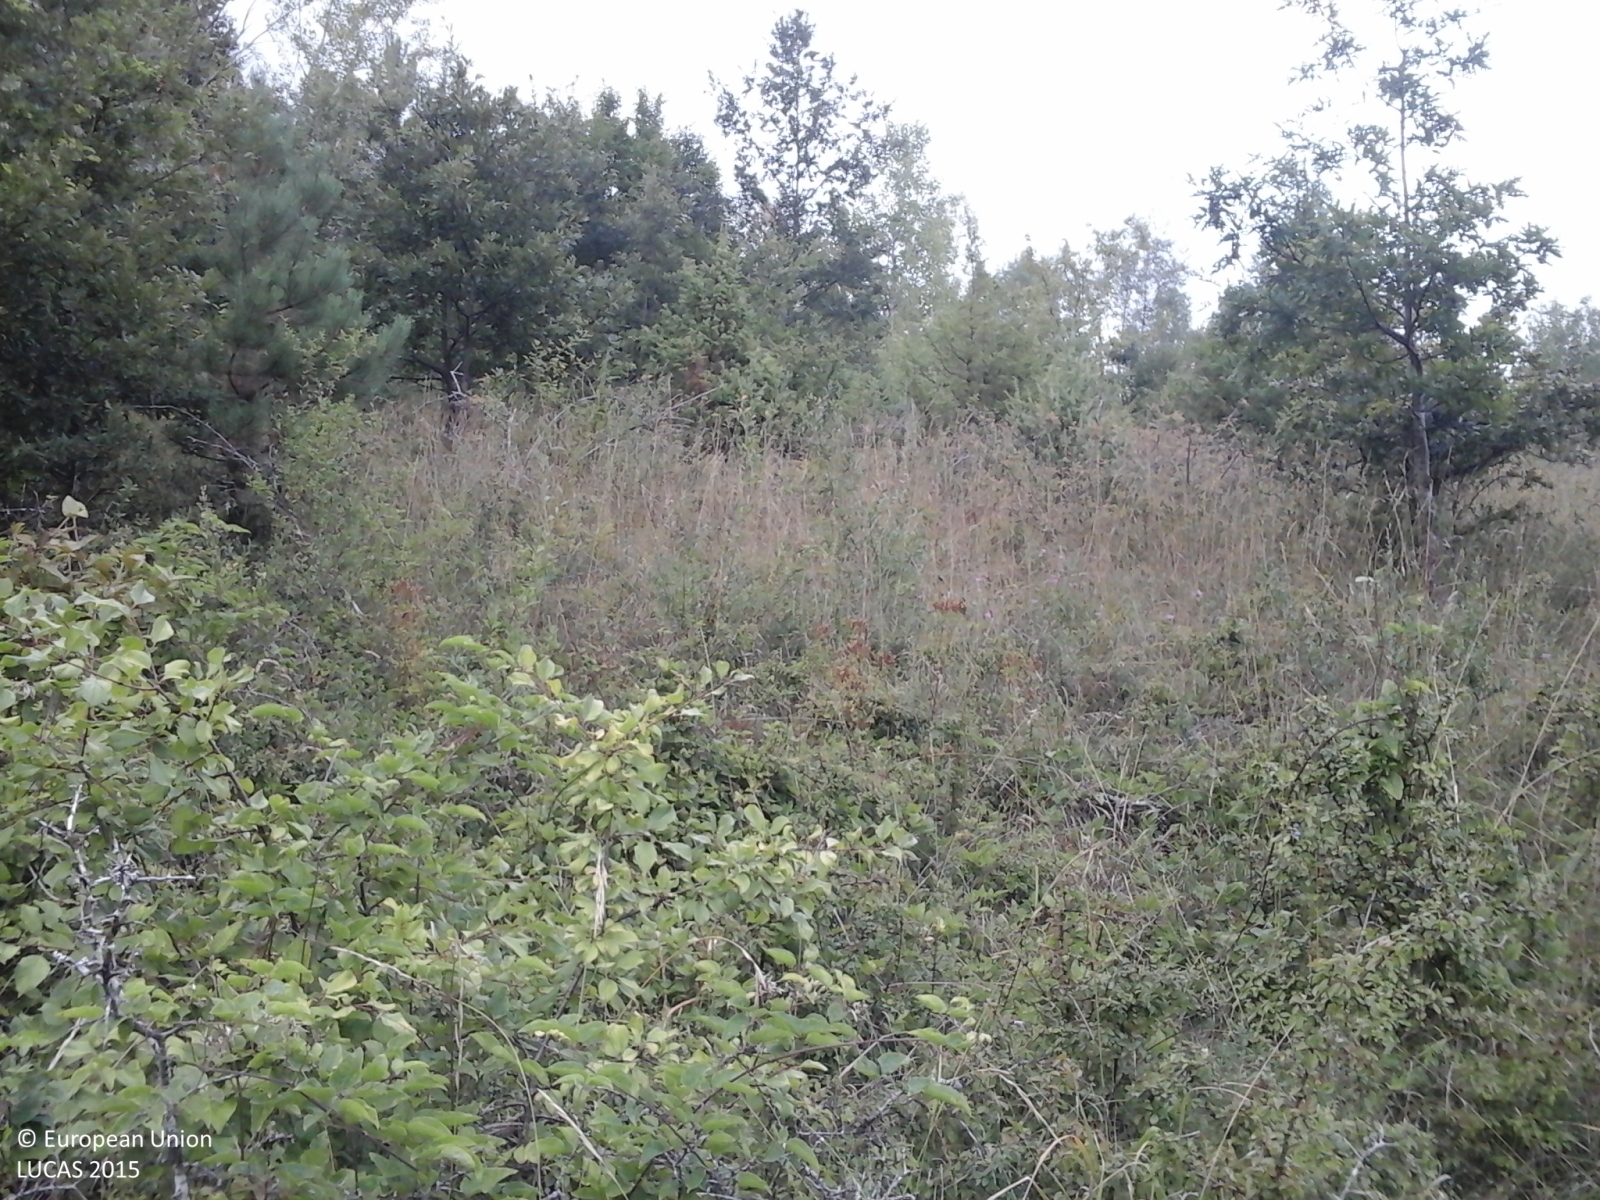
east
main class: Woodland
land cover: Broadleaved woodland
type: thermophilous deciduous forest
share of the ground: > 75 %
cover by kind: broadleaved forest trees 40 %, shrubs 40 %, herbaceous plants 15 %, coniferous forest trees 5 %
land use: Semi-natural and natural areas not in use
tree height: > 5 m
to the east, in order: Broadleaved woodland; Grassland with sparse tree/shrub cover; Other mixed woodland; Shrubland without tree cover; Other mixed woodland
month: August
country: IT
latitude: 44.7450
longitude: 9.3068
